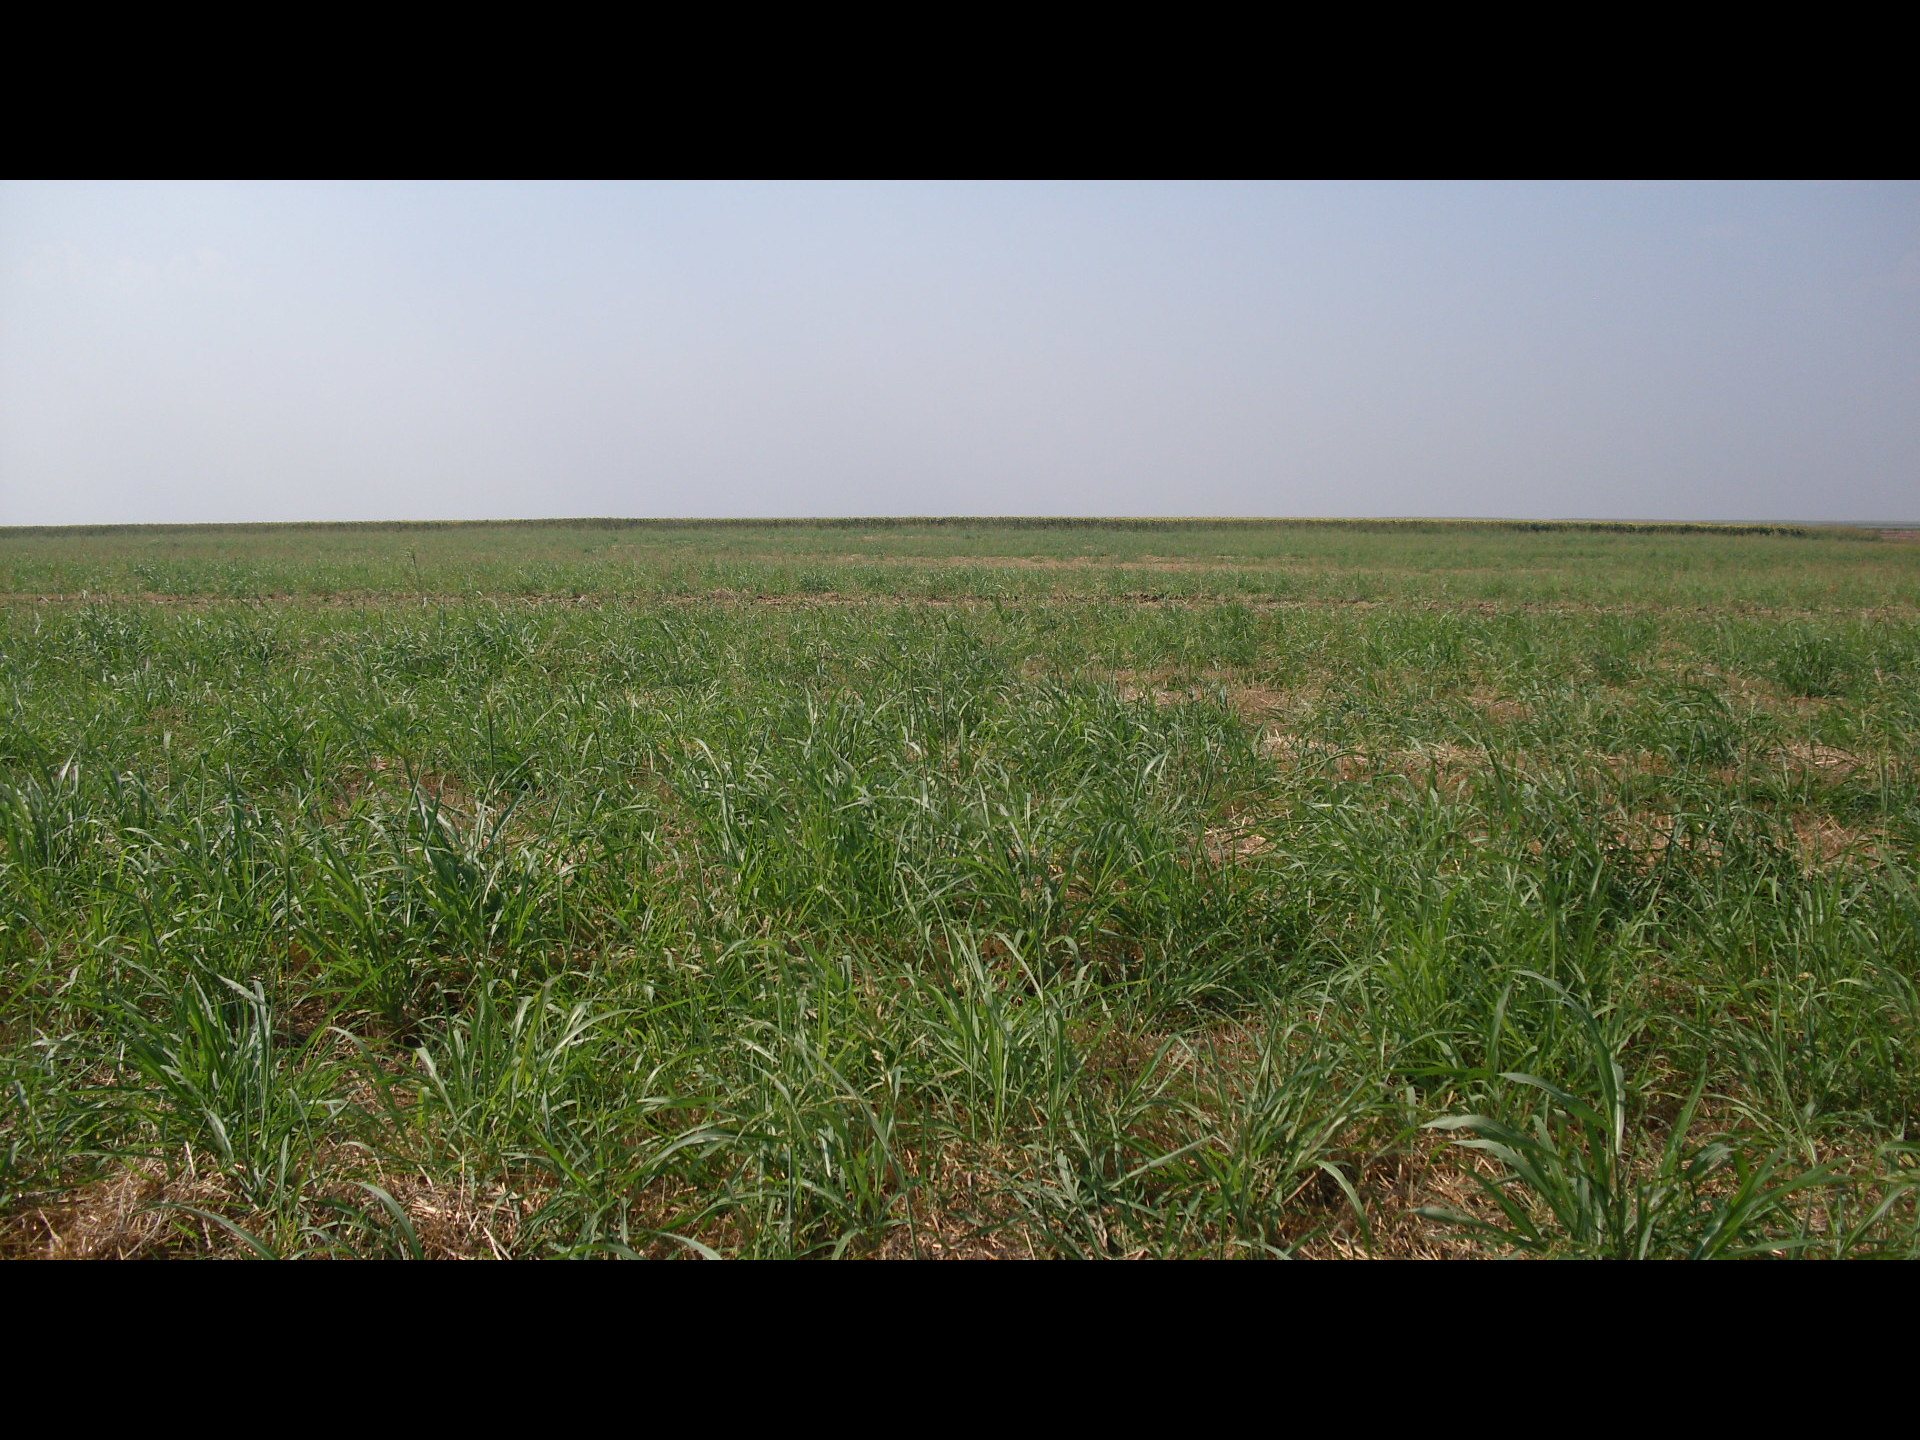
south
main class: Cropland
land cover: Barley
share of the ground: > 75 %
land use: Agriculture (excluding fallow land and kitchen gardens)
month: July
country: BG
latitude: 43.7289
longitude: 23.5671
